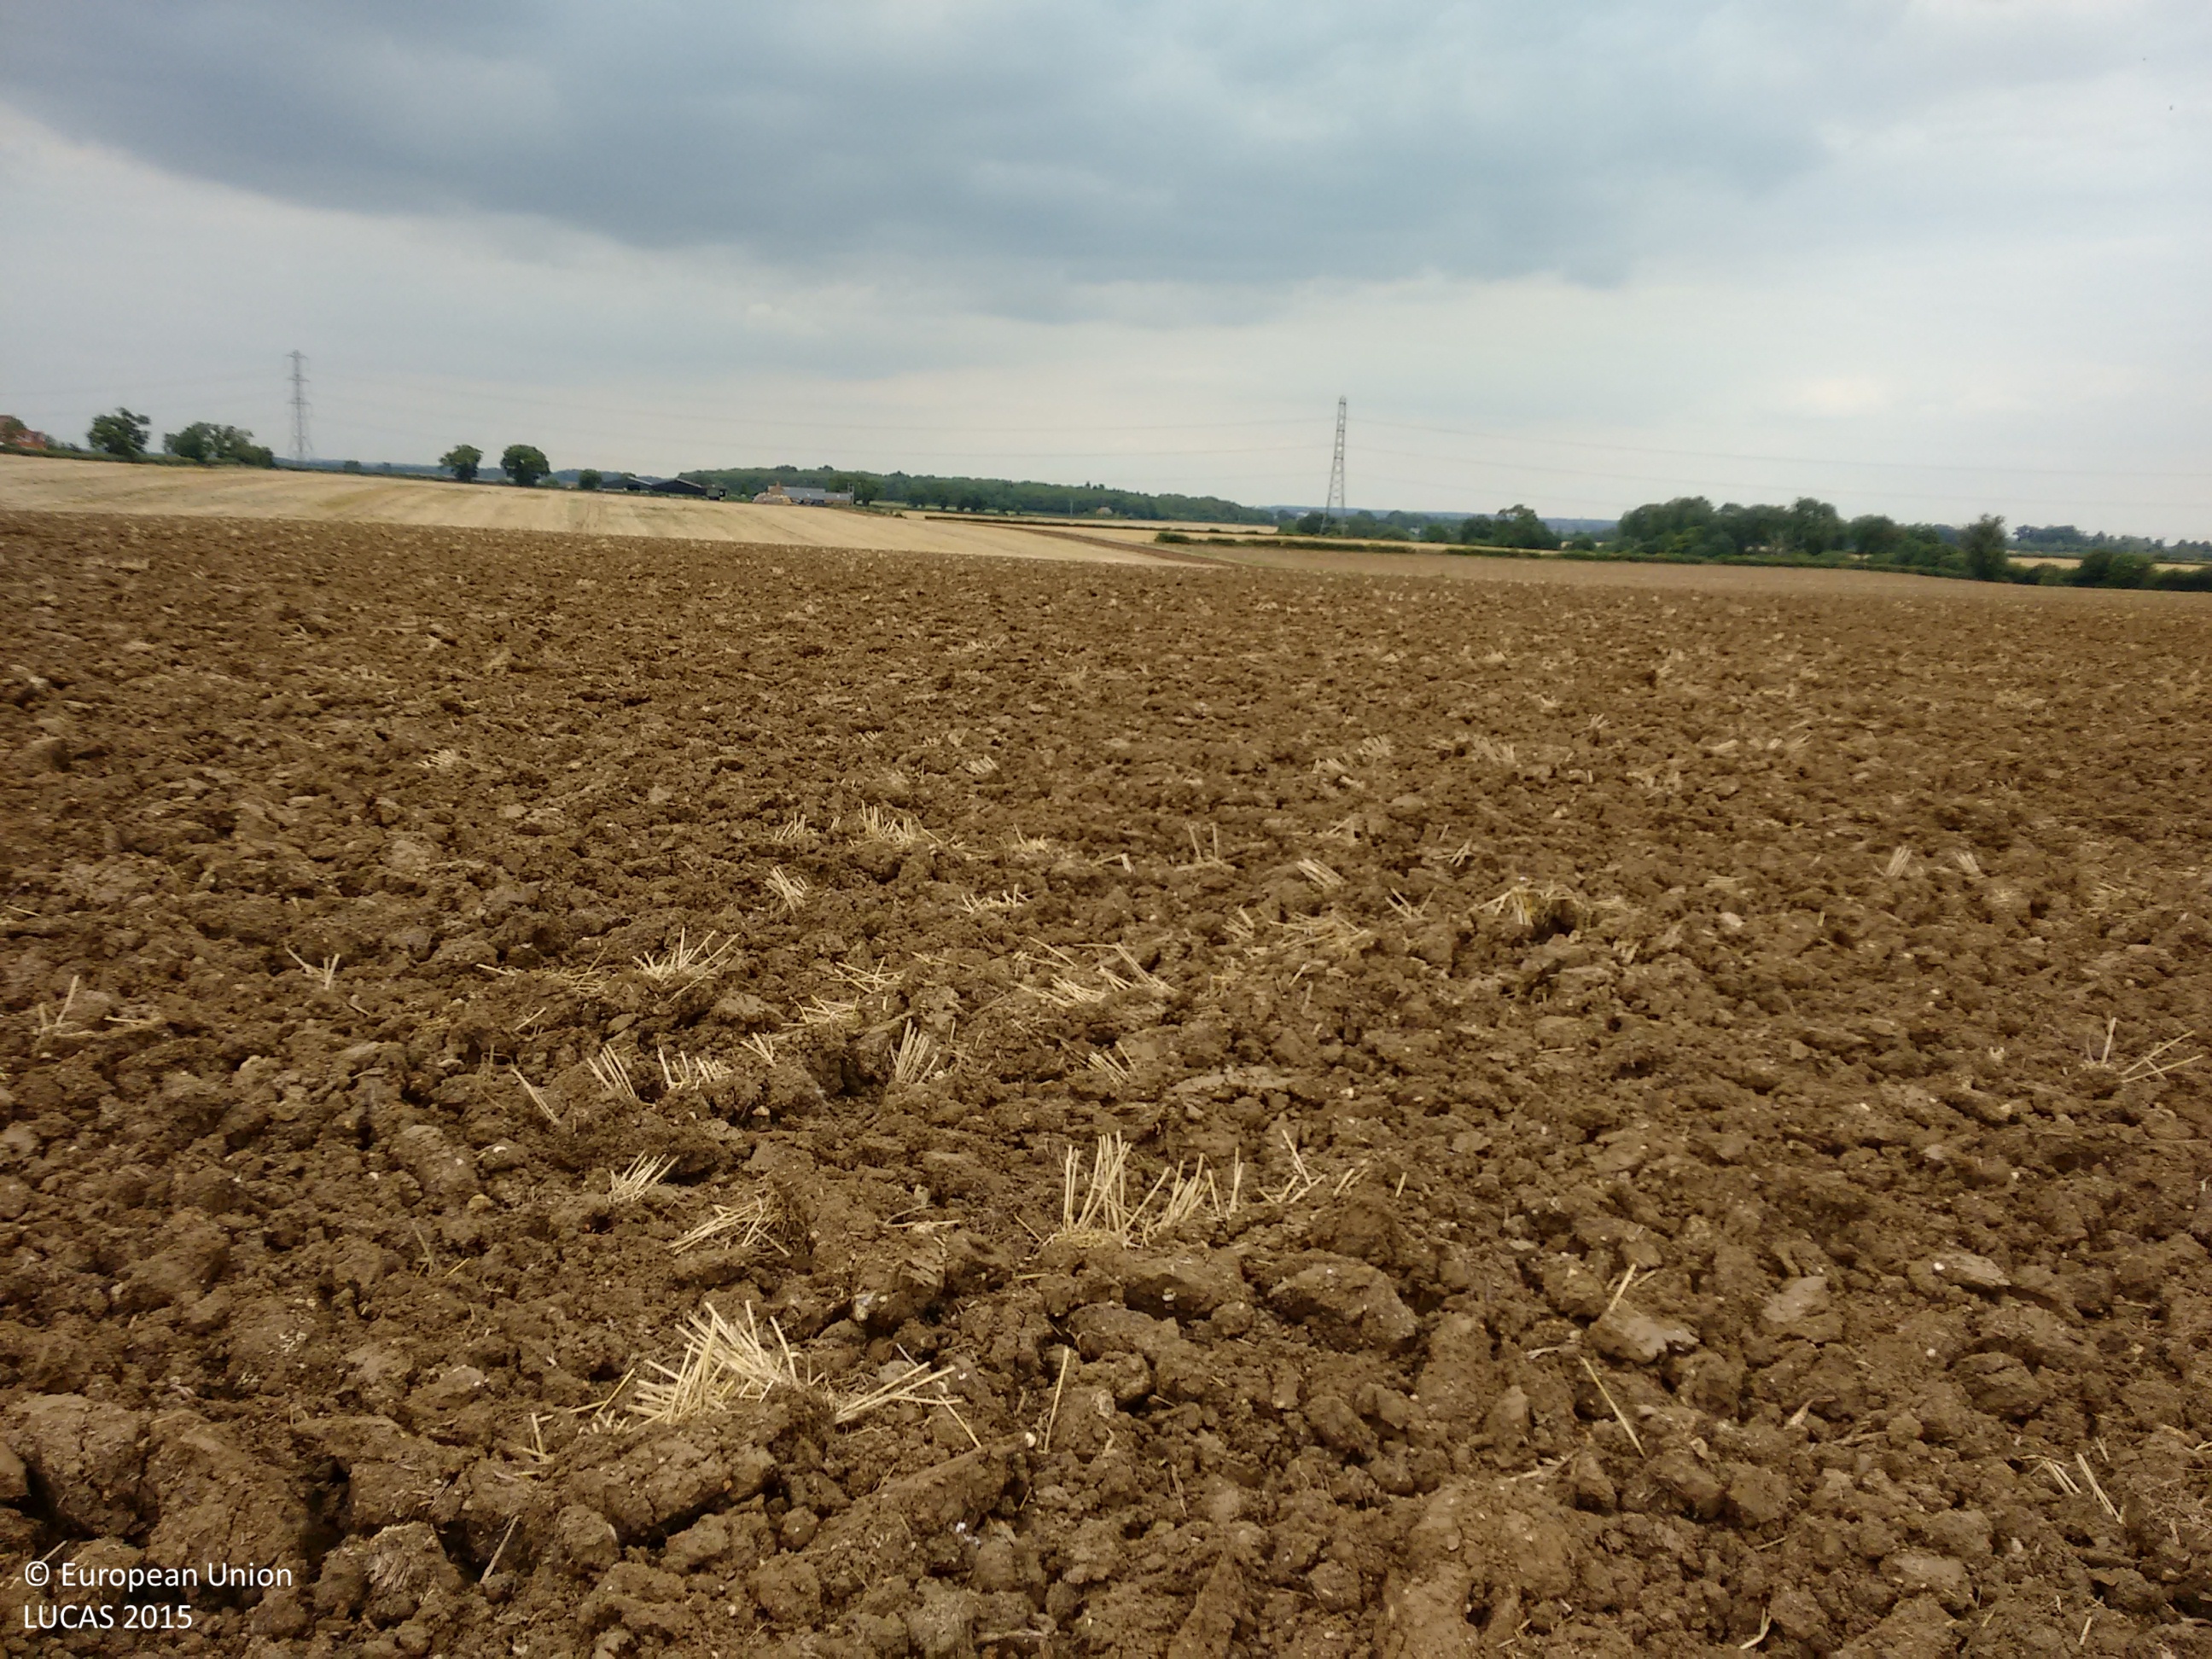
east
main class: Cropland
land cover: Common wheat
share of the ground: < 10 %
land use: Agriculture (excluding fallow land and kitchen gardens)
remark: Harvested field
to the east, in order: Common wheat
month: August
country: GB
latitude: 52.3723
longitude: -0.8083
